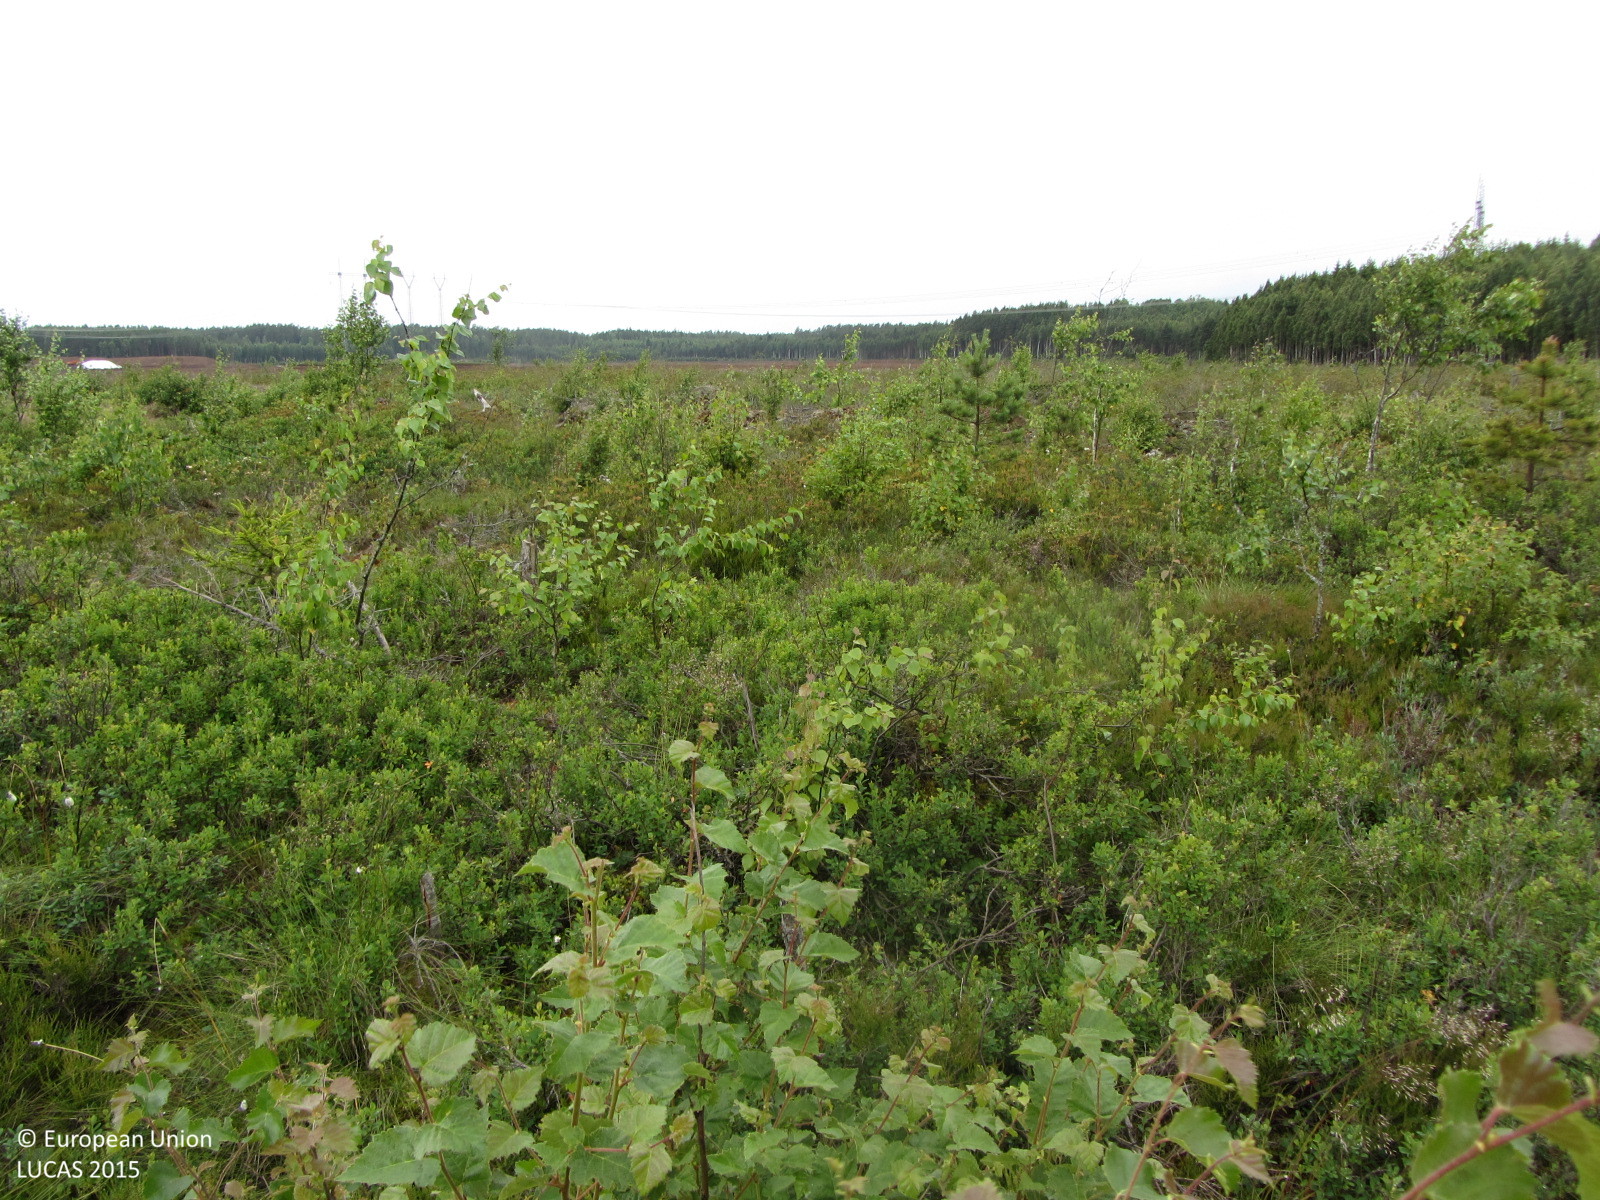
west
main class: Woodland
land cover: Broadleaved woodland
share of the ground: 25 - 50 %
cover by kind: shrubs 50 %, broadleaved forest trees 40 %, coniferous forest trees 5 %, herbaceous plants 5 %
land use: Forestry
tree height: < 5 m
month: July
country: FI
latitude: 60.0338
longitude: 23.9363
